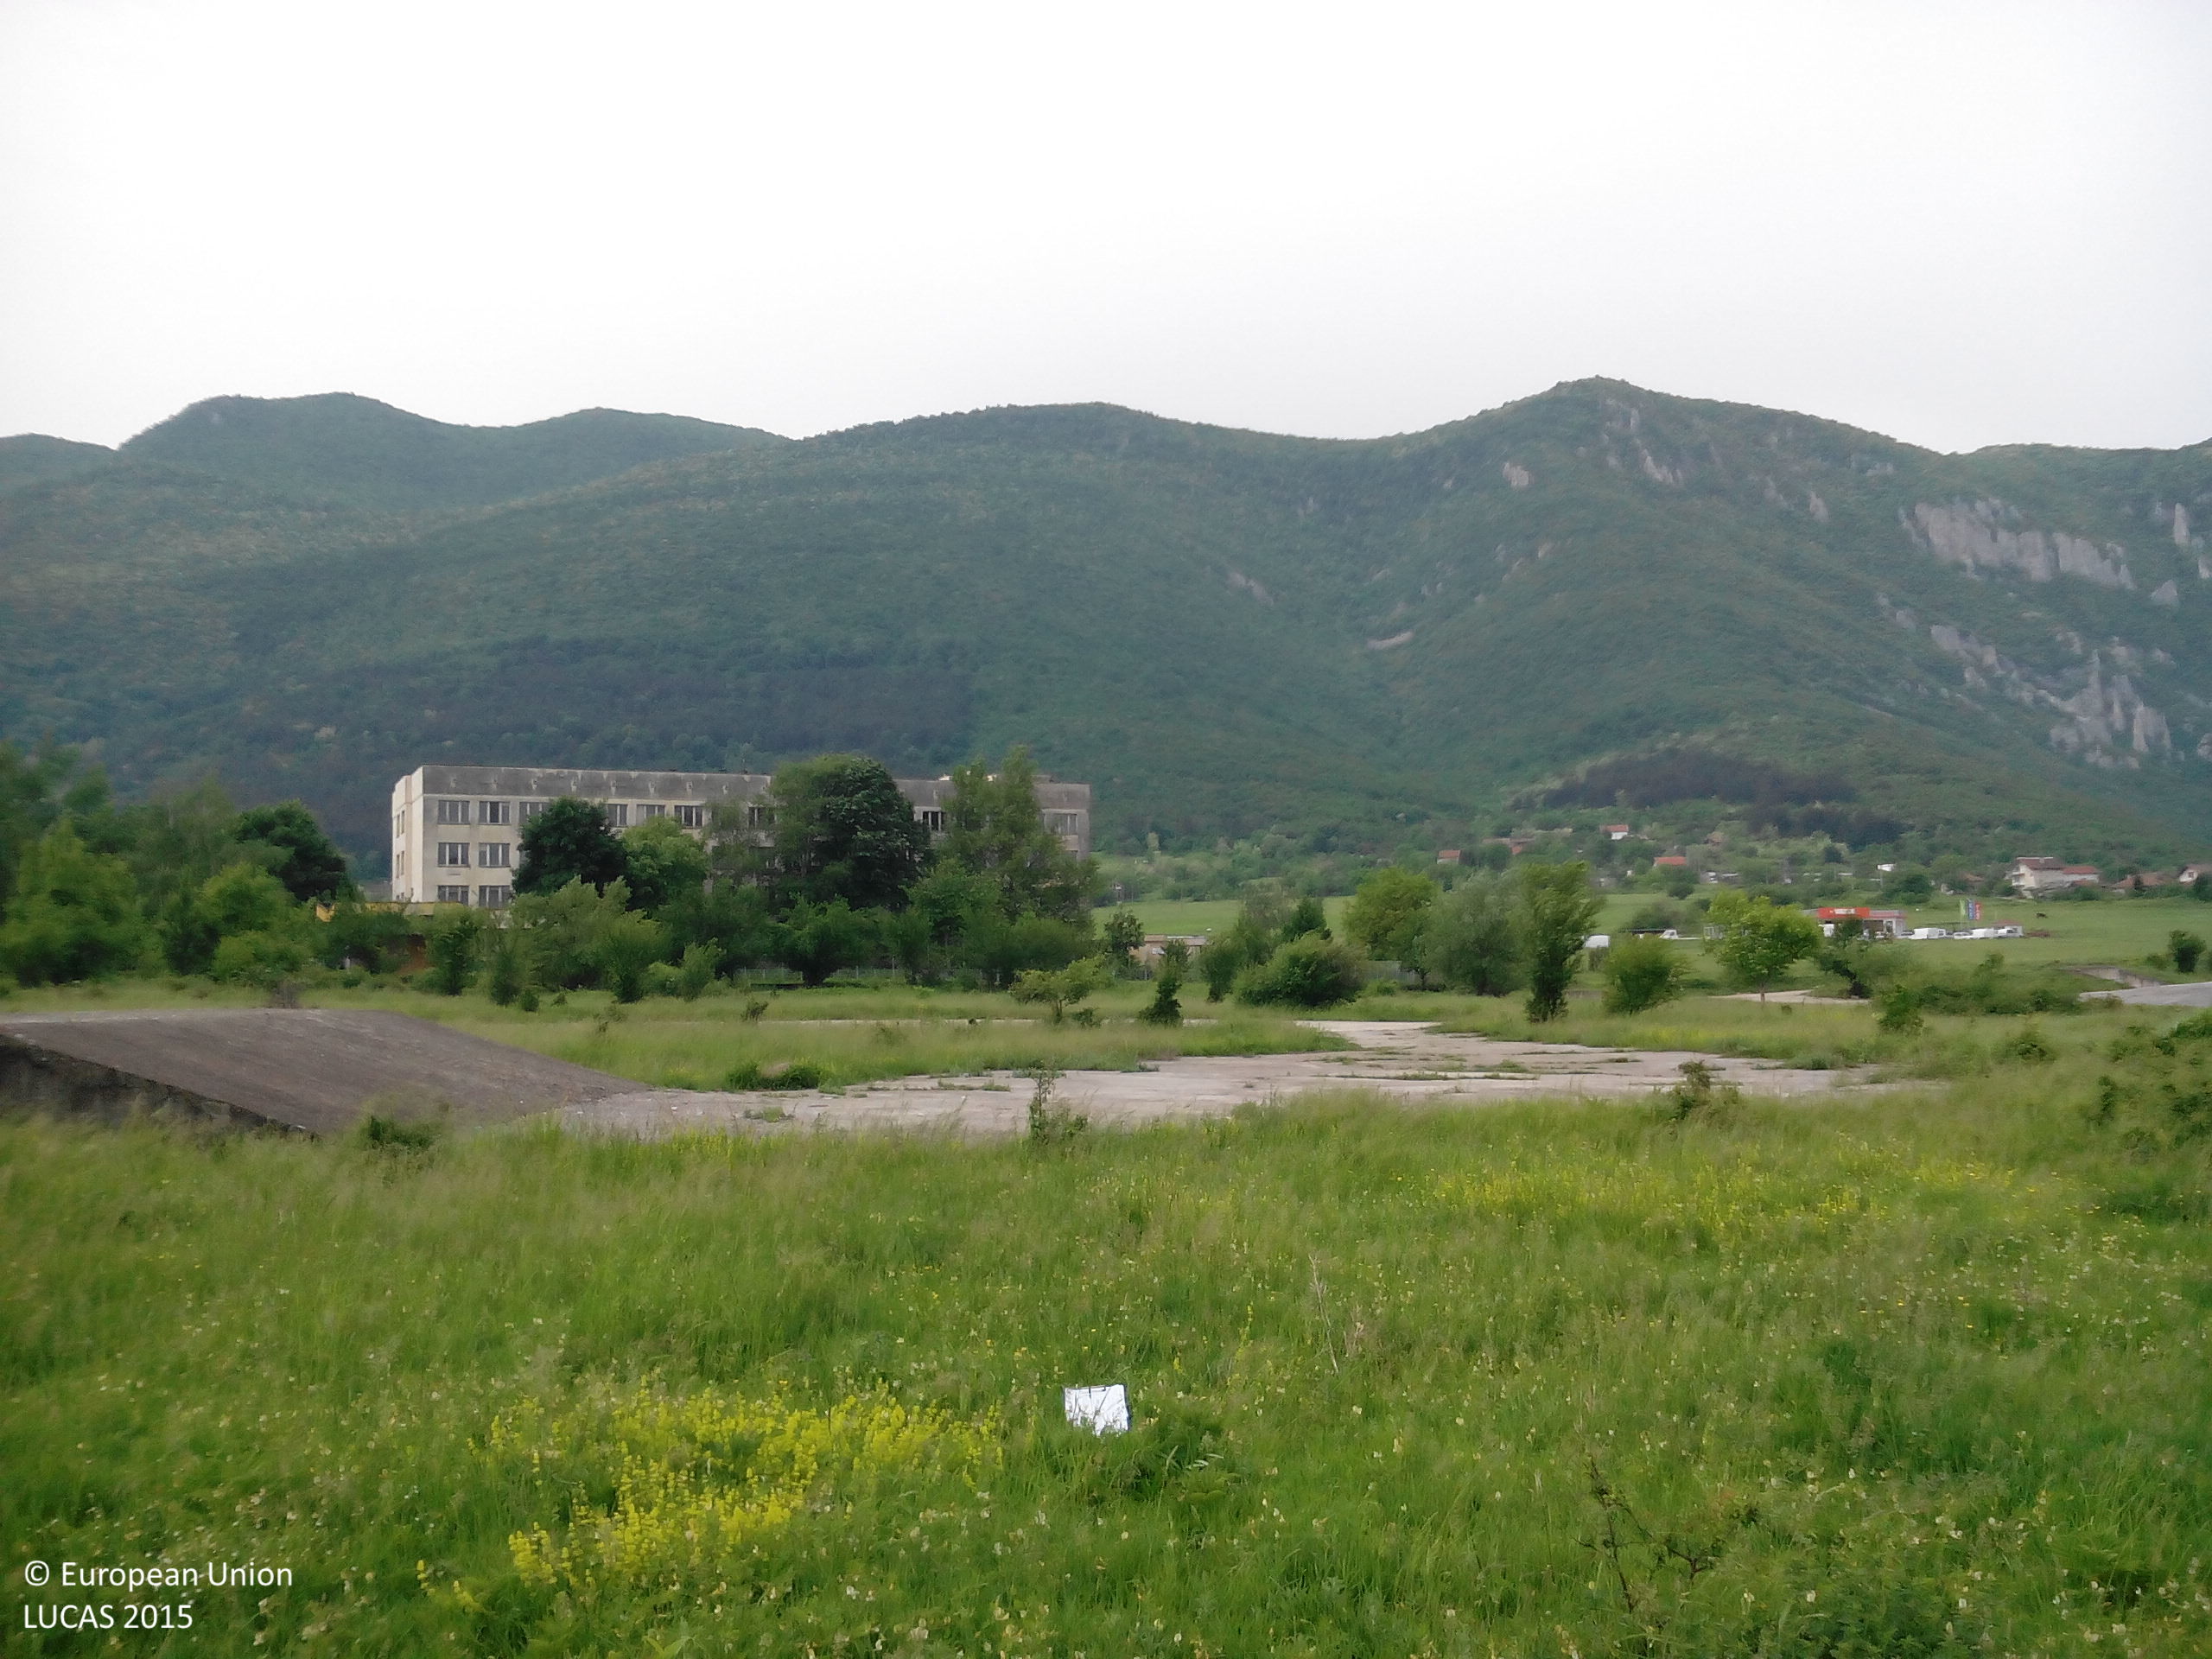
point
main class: Grassland
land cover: Grassland without tree/shrub cover
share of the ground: > 75 %
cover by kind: herbaceous plants 95 %, shrubs 5 %
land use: Abandoned areas
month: May
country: BG
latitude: 43.2231
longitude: 23.5233
